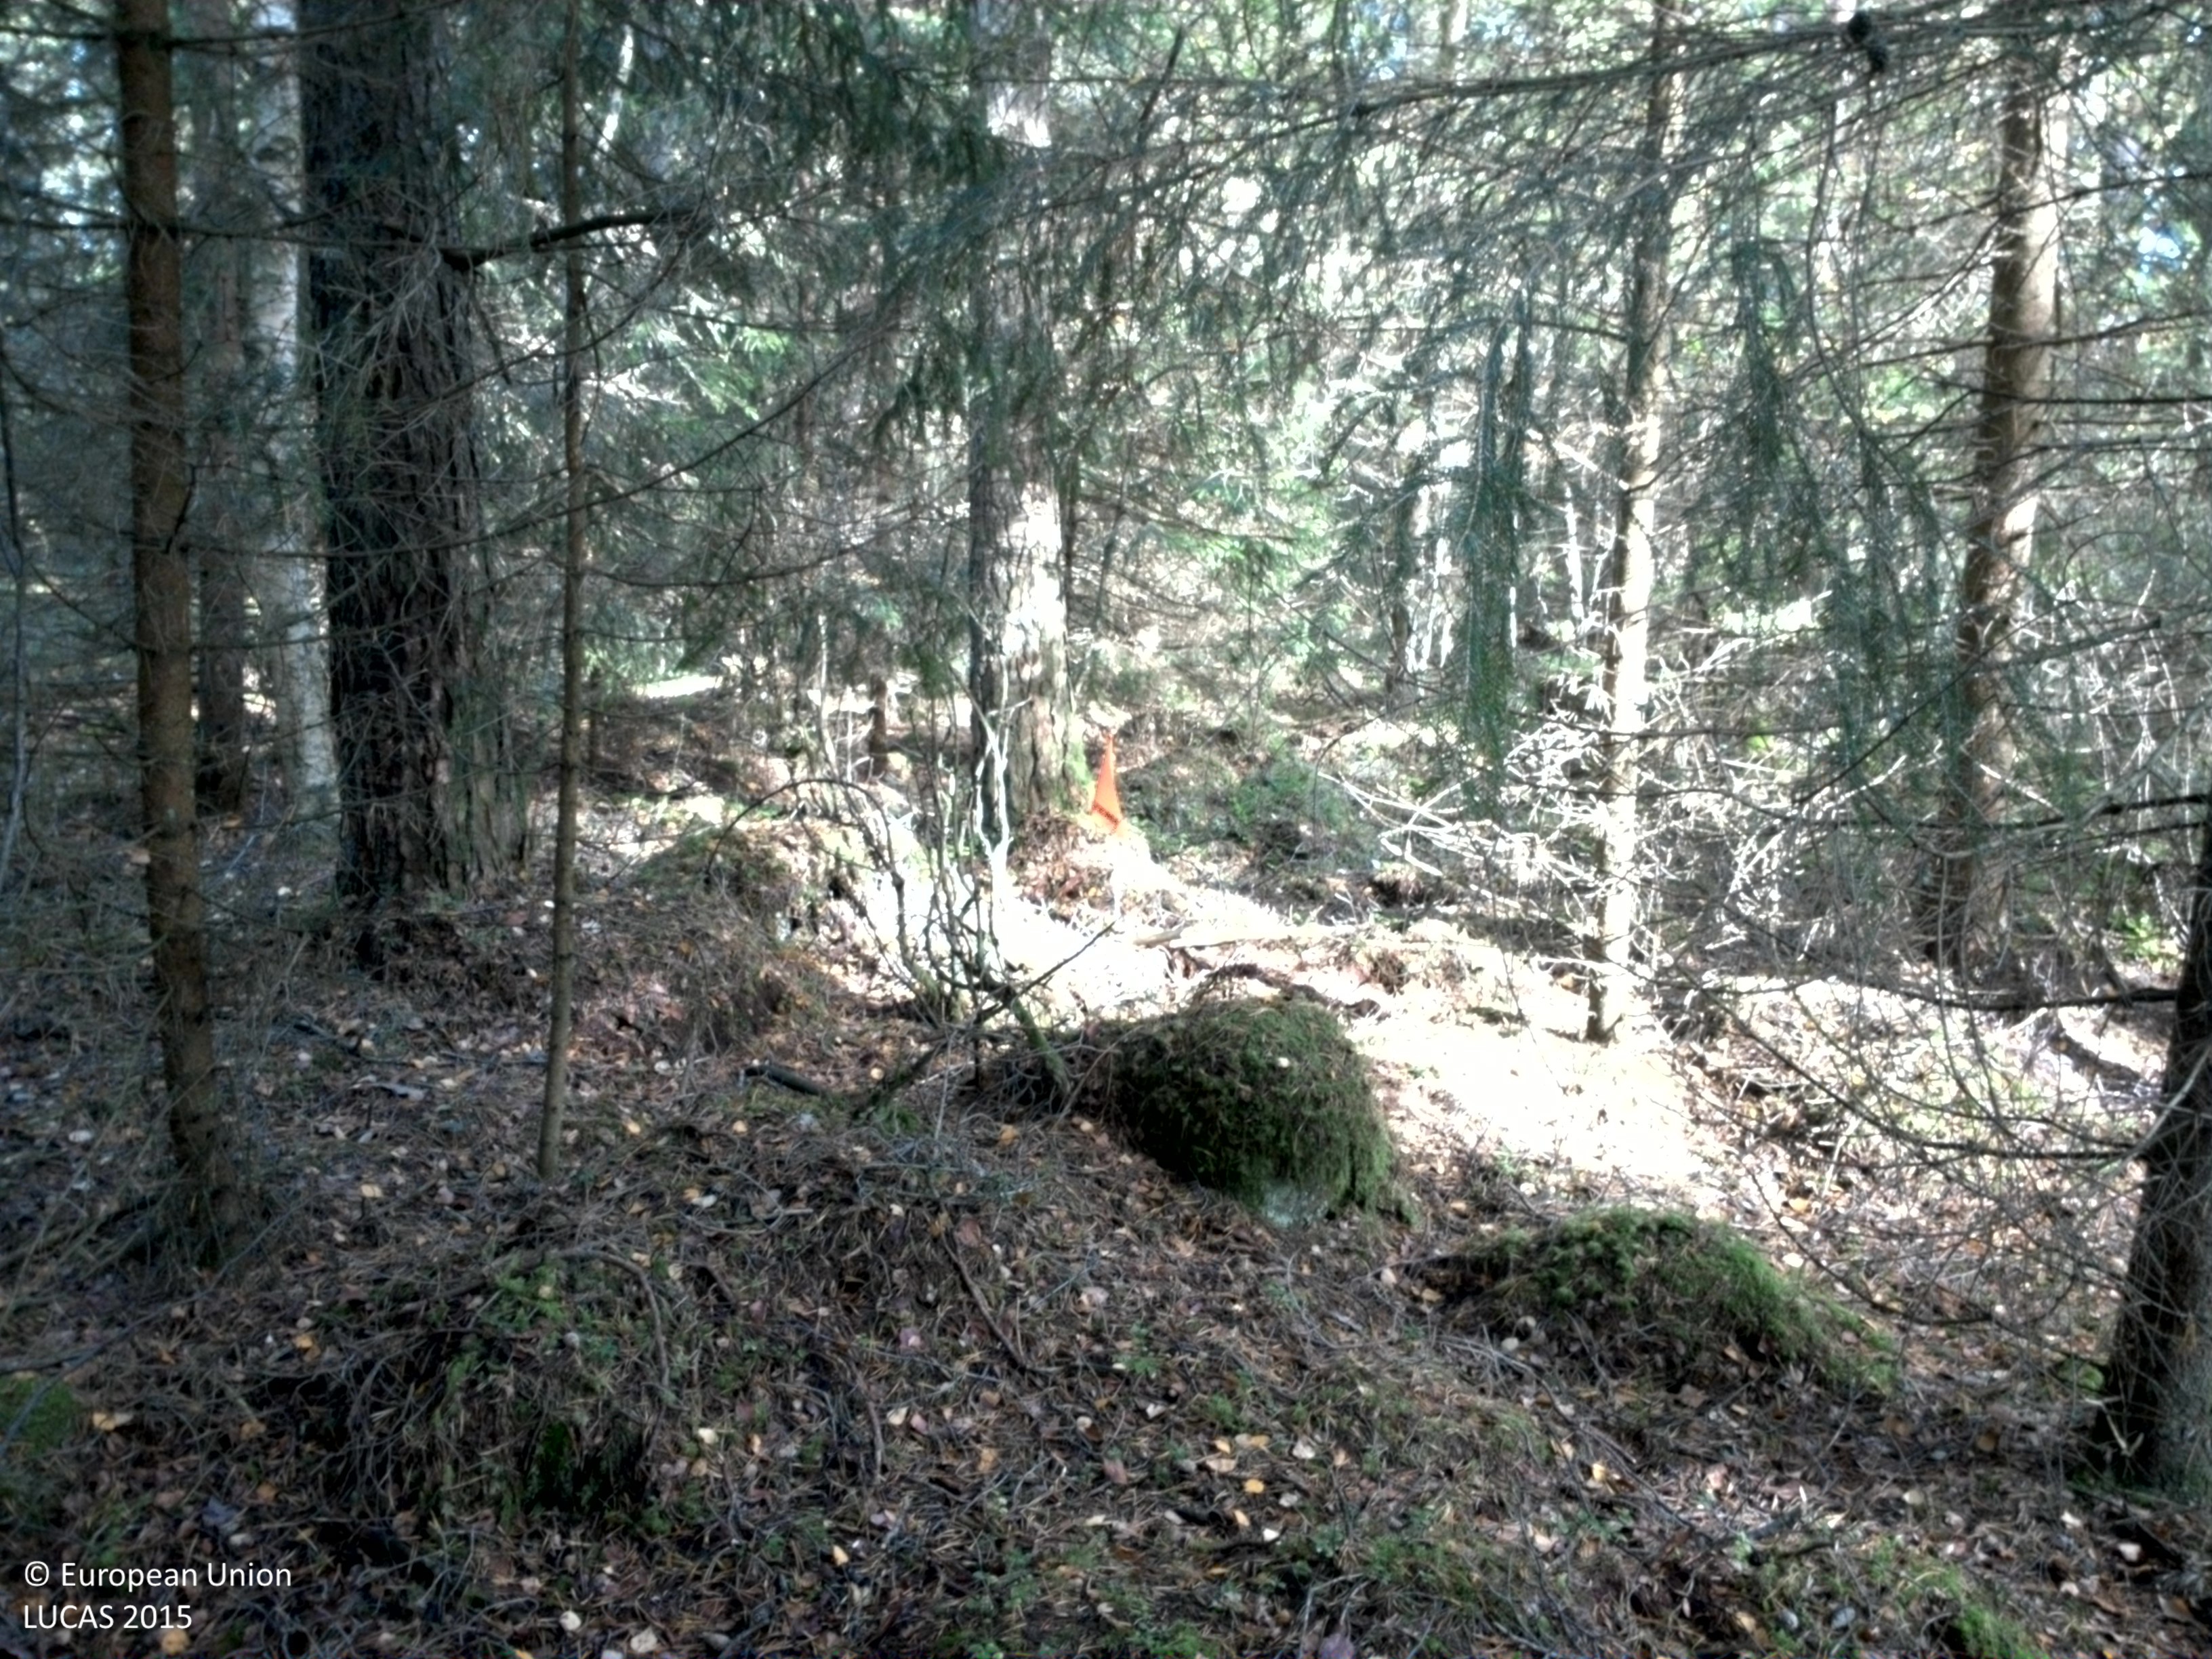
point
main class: Woodland
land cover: Pine dominated coniferous woodland
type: boreal forest
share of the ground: > 75 %
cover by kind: coniferous forest trees 85 %, broadleaved forest trees 5 %, shrubs 5 %, lichens and mosses 5 %
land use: Forestry
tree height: > 5 m
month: September
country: SE
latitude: 58.0032
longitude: 13.1253
